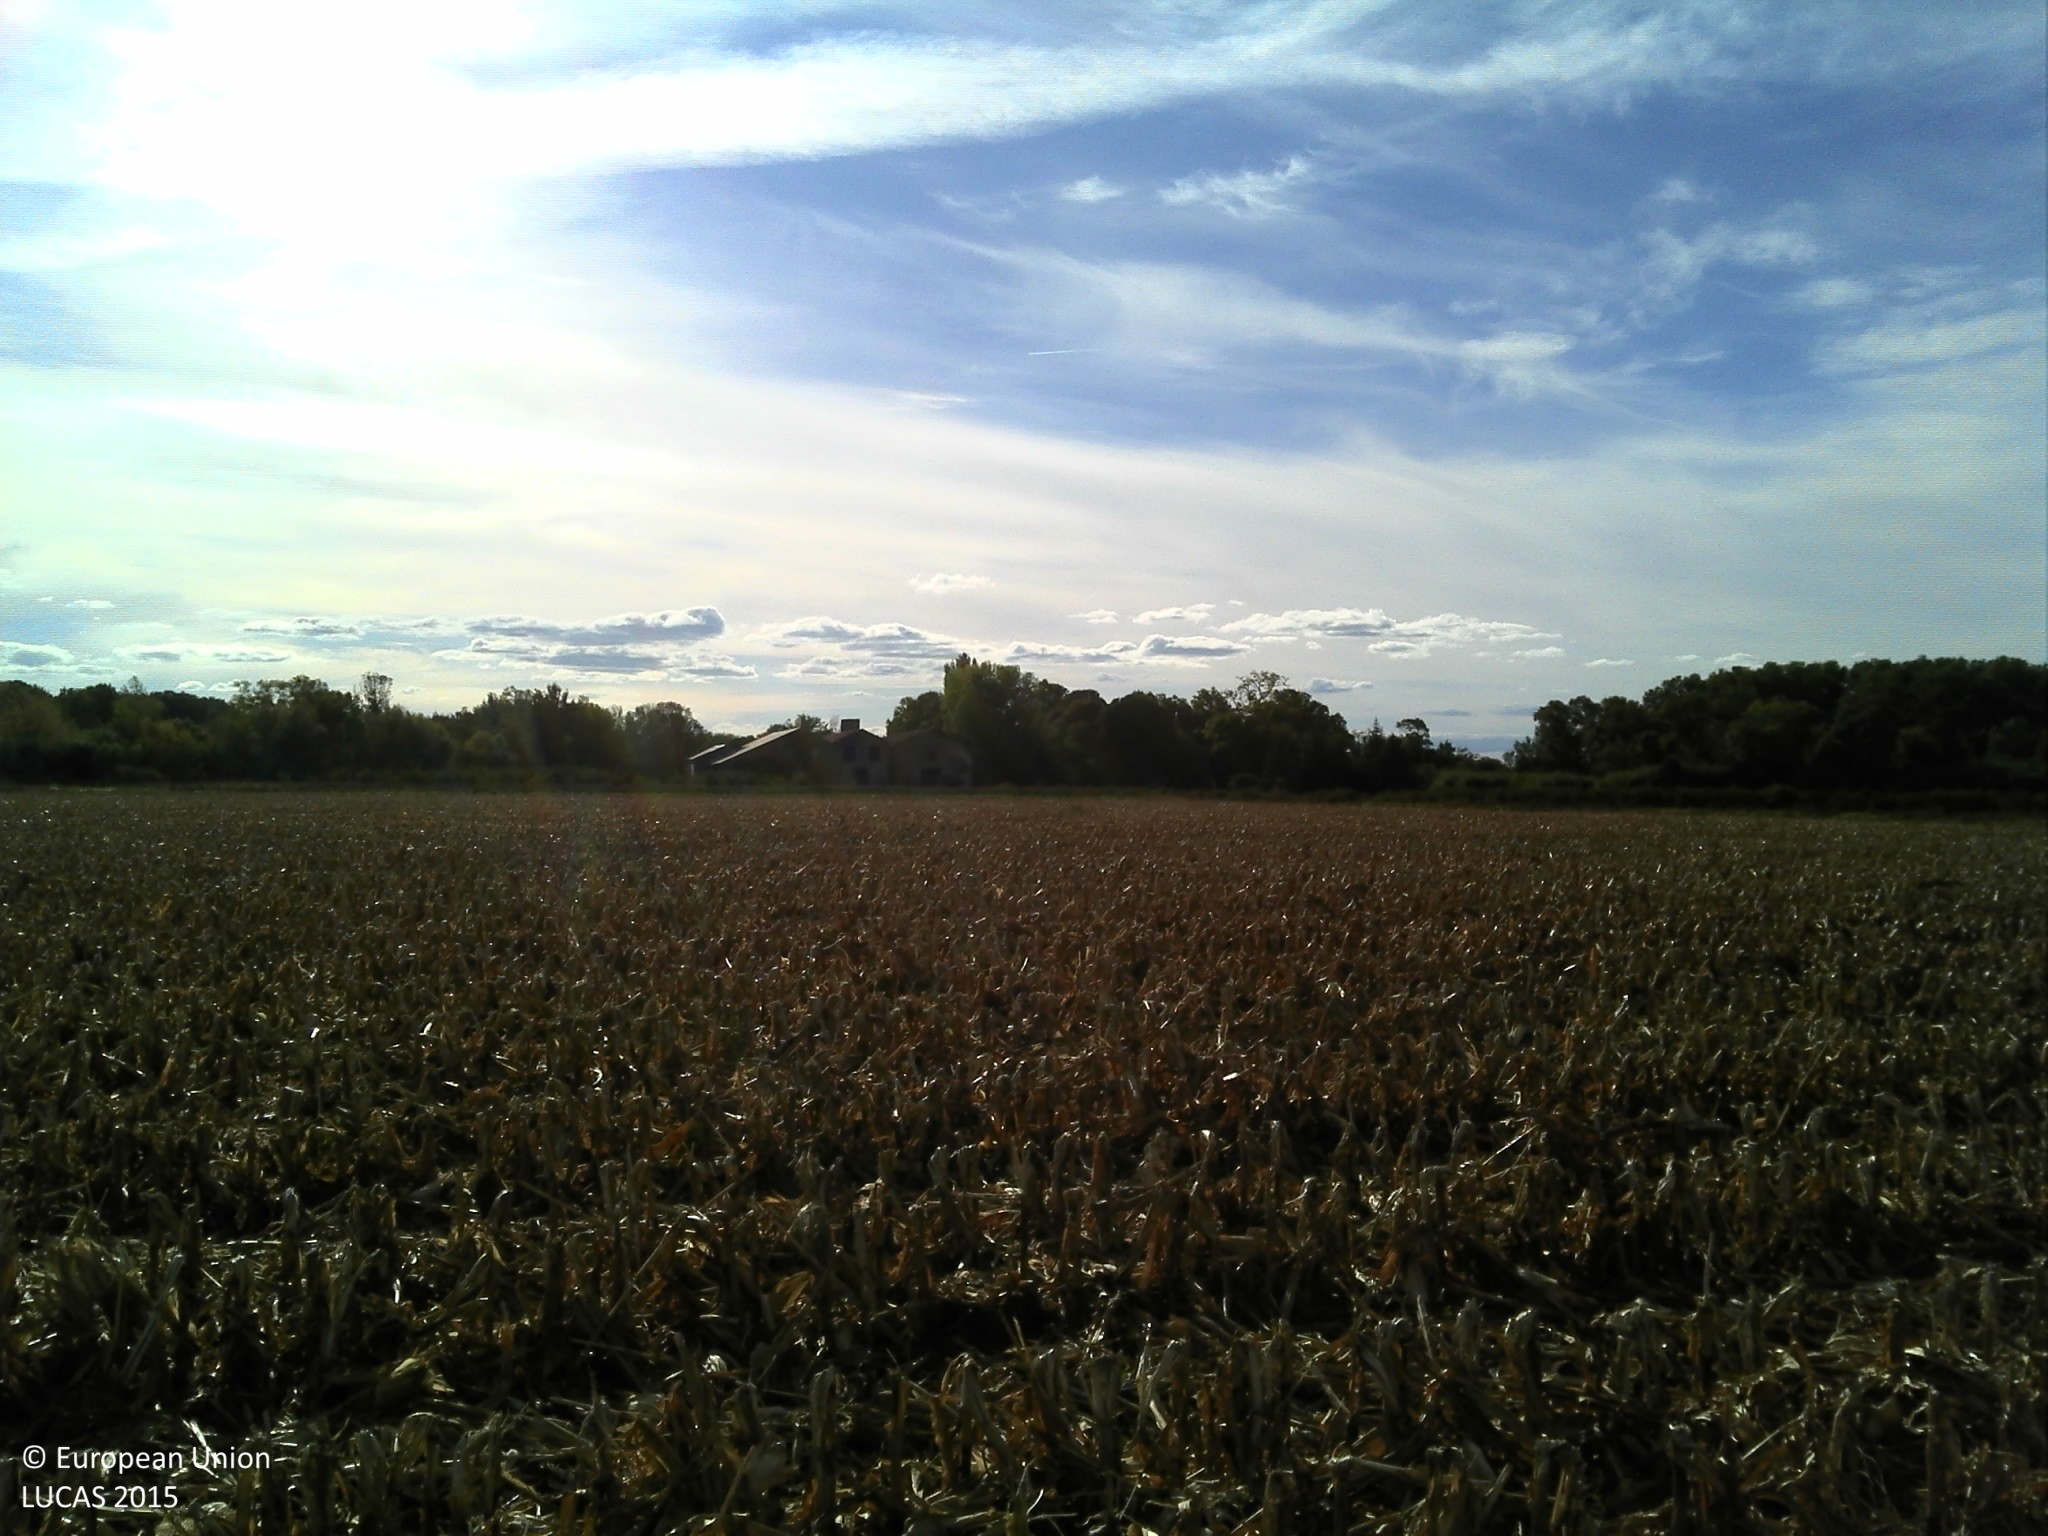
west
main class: Cropland
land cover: Maize
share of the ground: 50 - 75 %
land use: Agriculture (excluding fallow land and kitchen gardens)
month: October
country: FR
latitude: 43.4002
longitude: 3.4285
